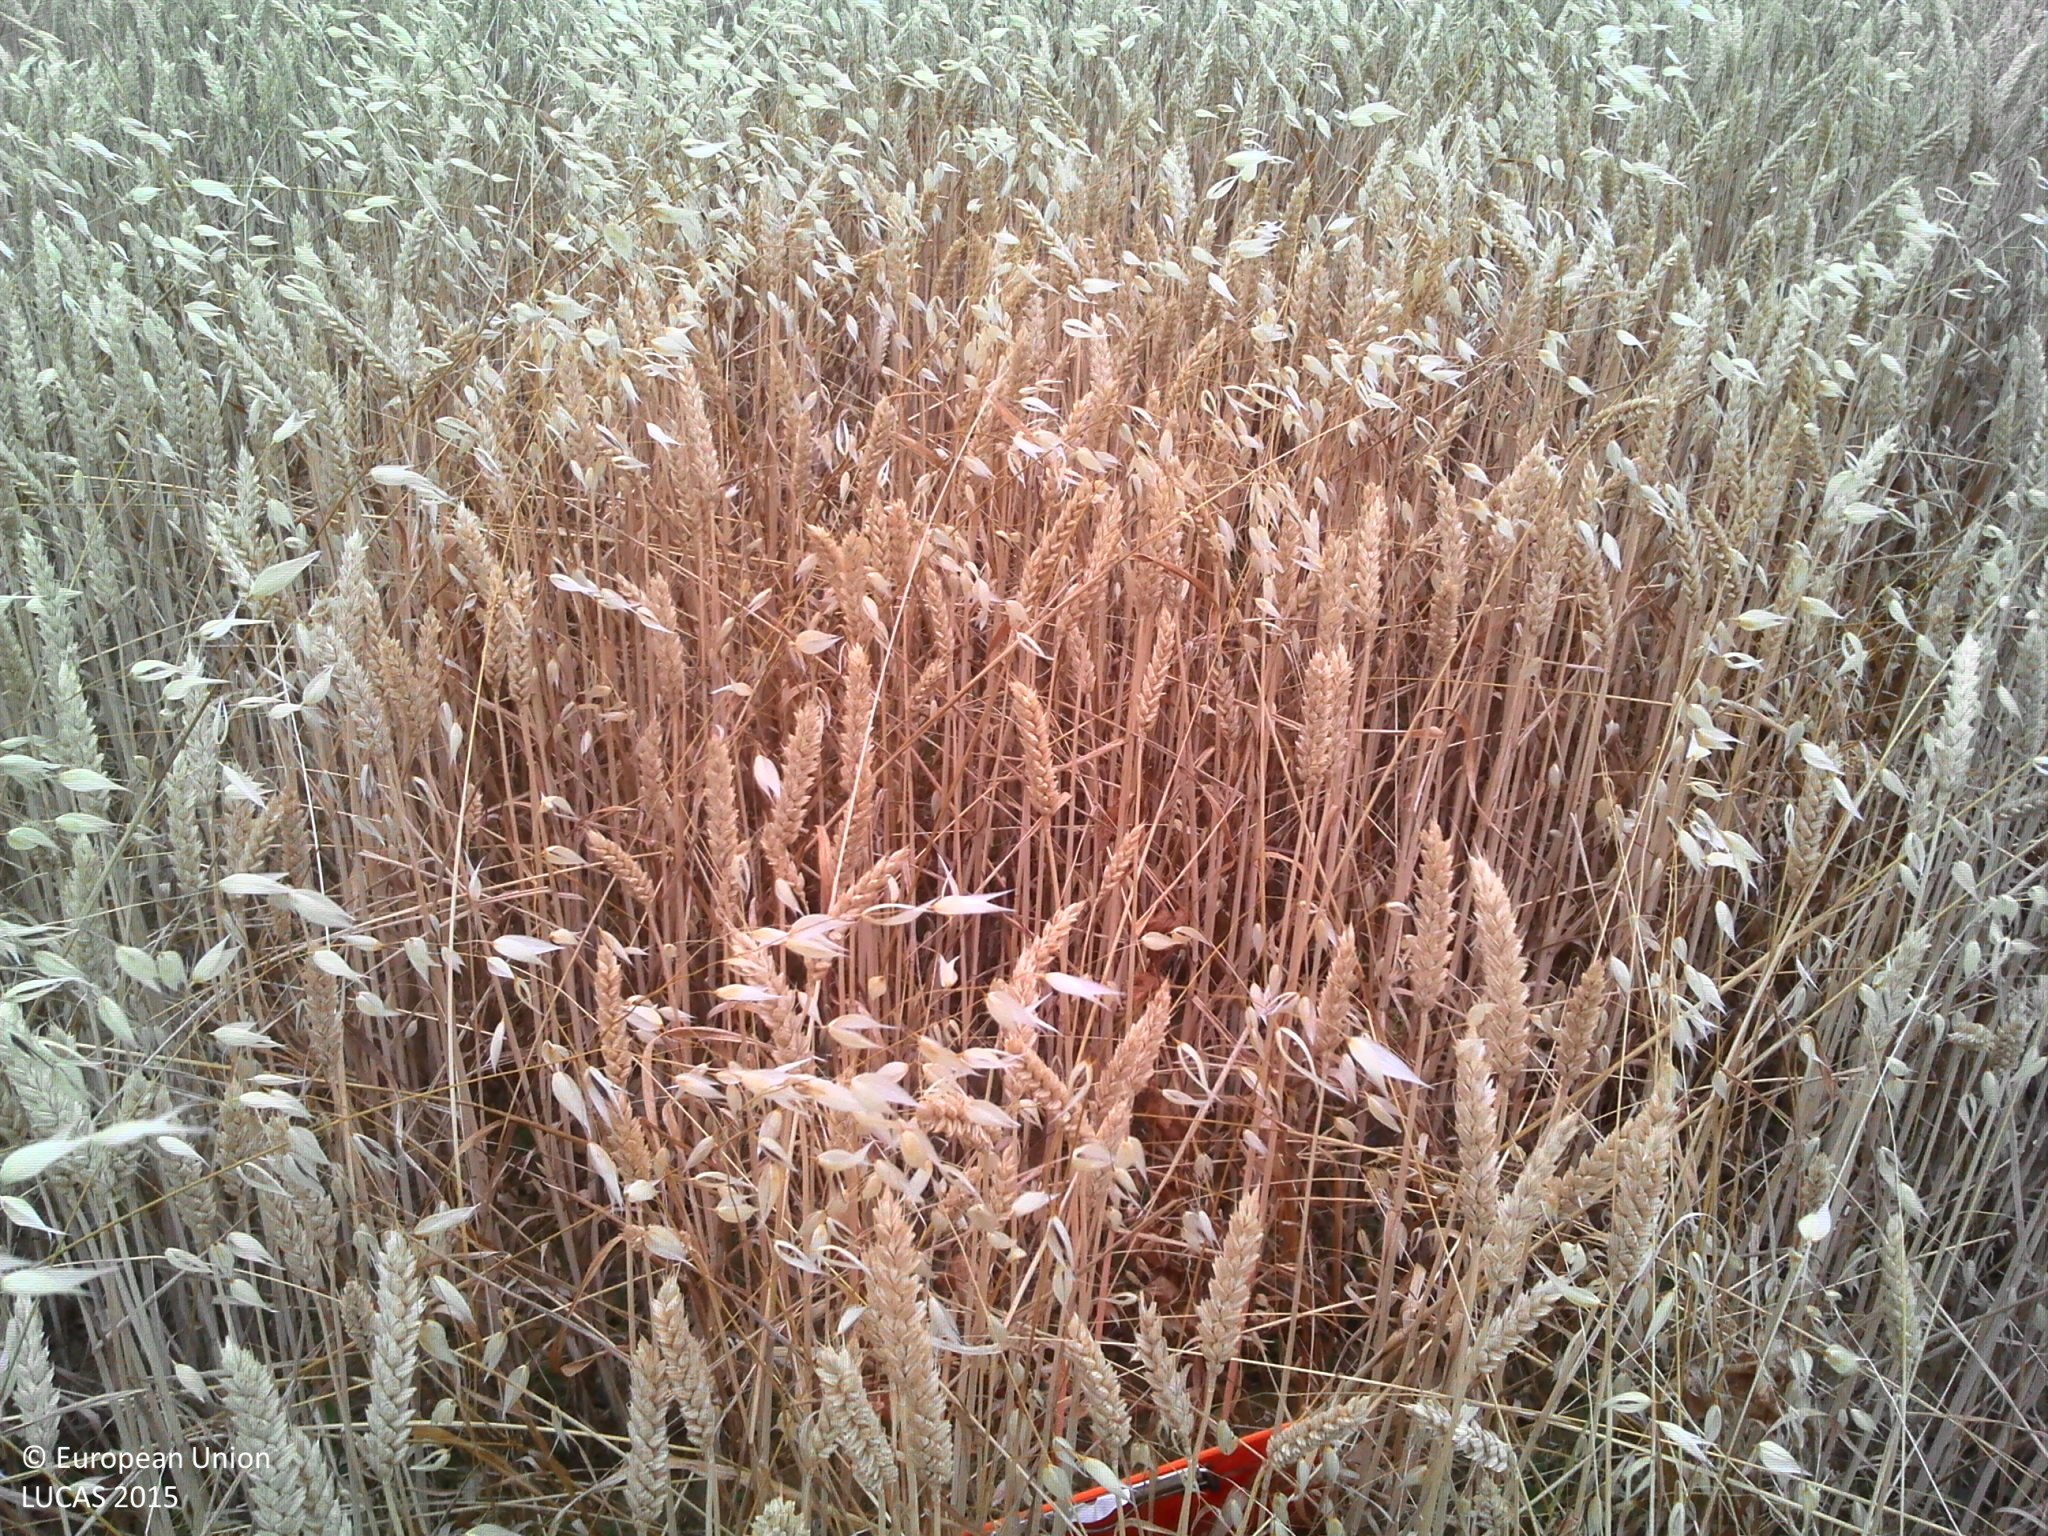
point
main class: Cropland
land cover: Mixed cereals for fodder
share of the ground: > 75 %
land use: Agriculture (excluding fallow land and kitchen gardens)
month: July
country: FR
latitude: 45.2235
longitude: 5.0000
